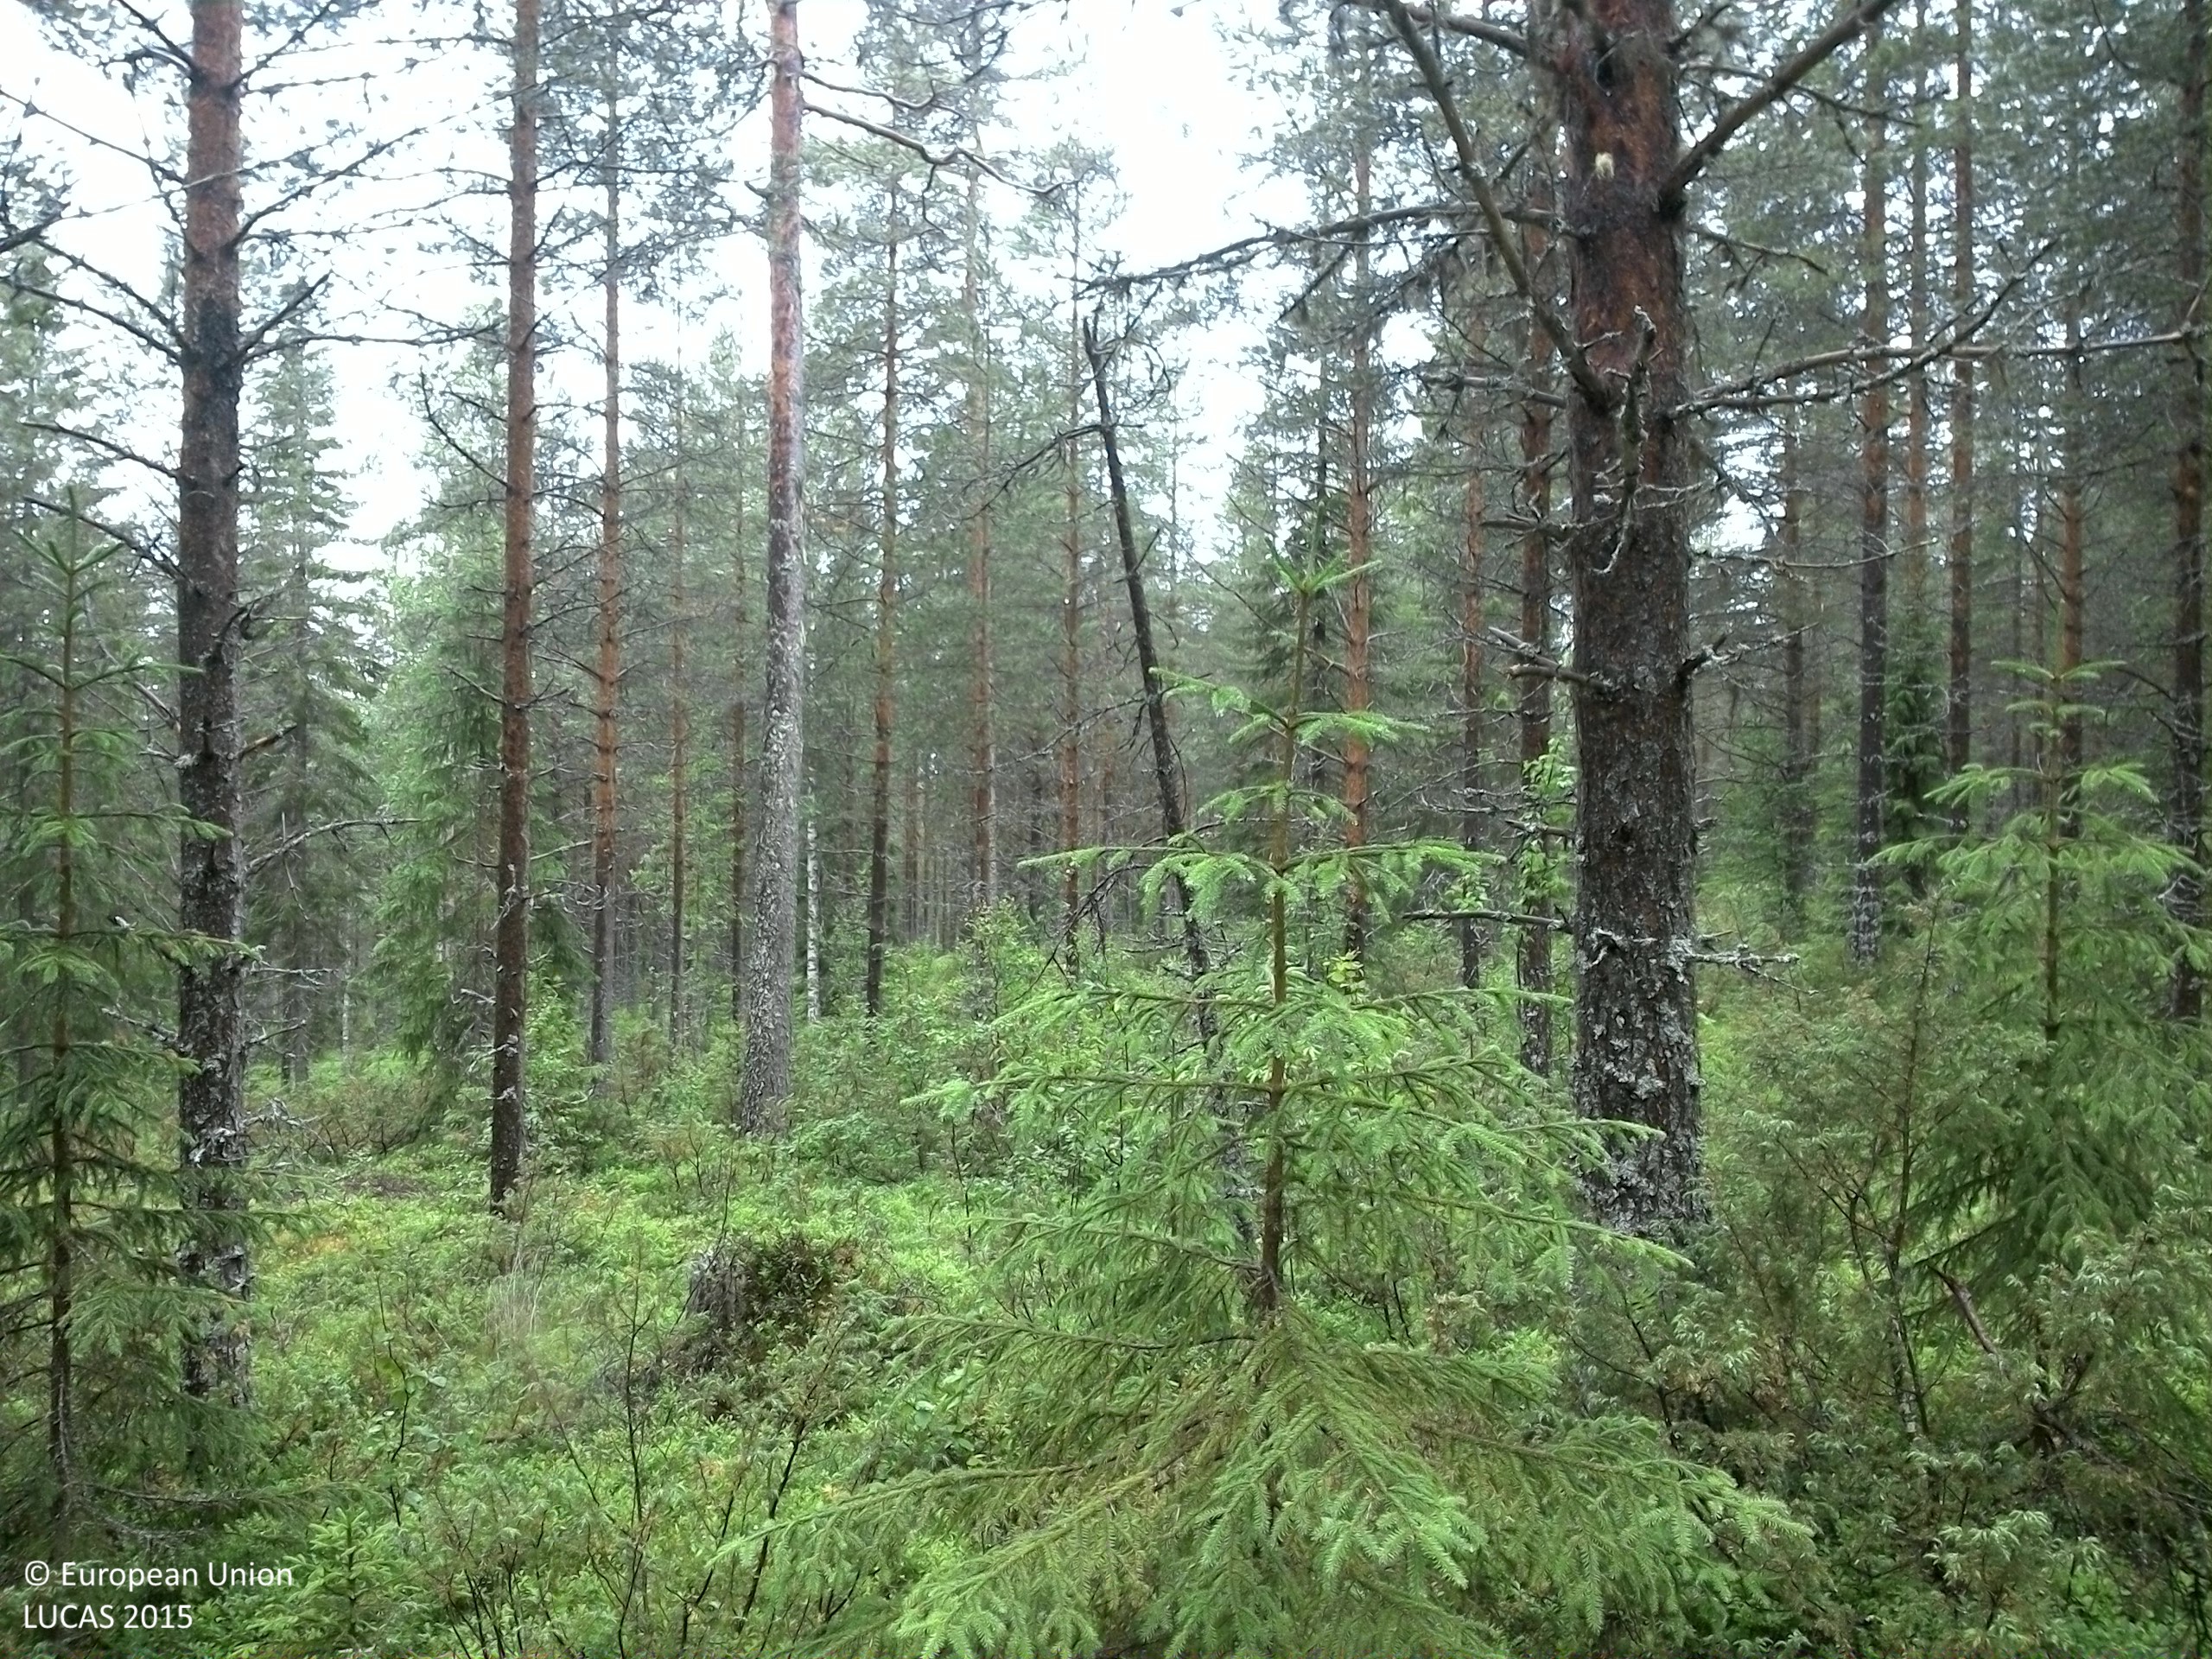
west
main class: Woodland
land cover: Pine dominated mixed woodland
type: boreal forest
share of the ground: 50 - 75 %
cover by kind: coniferous forest trees 40 %, broadleaved forest trees 20 %, shrubs 20 %, herbaceous plants 10 %, lichens and mosses 10 %
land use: Forestry
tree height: > 5 m
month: July
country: SE
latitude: 63.6854
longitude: 17.3121
